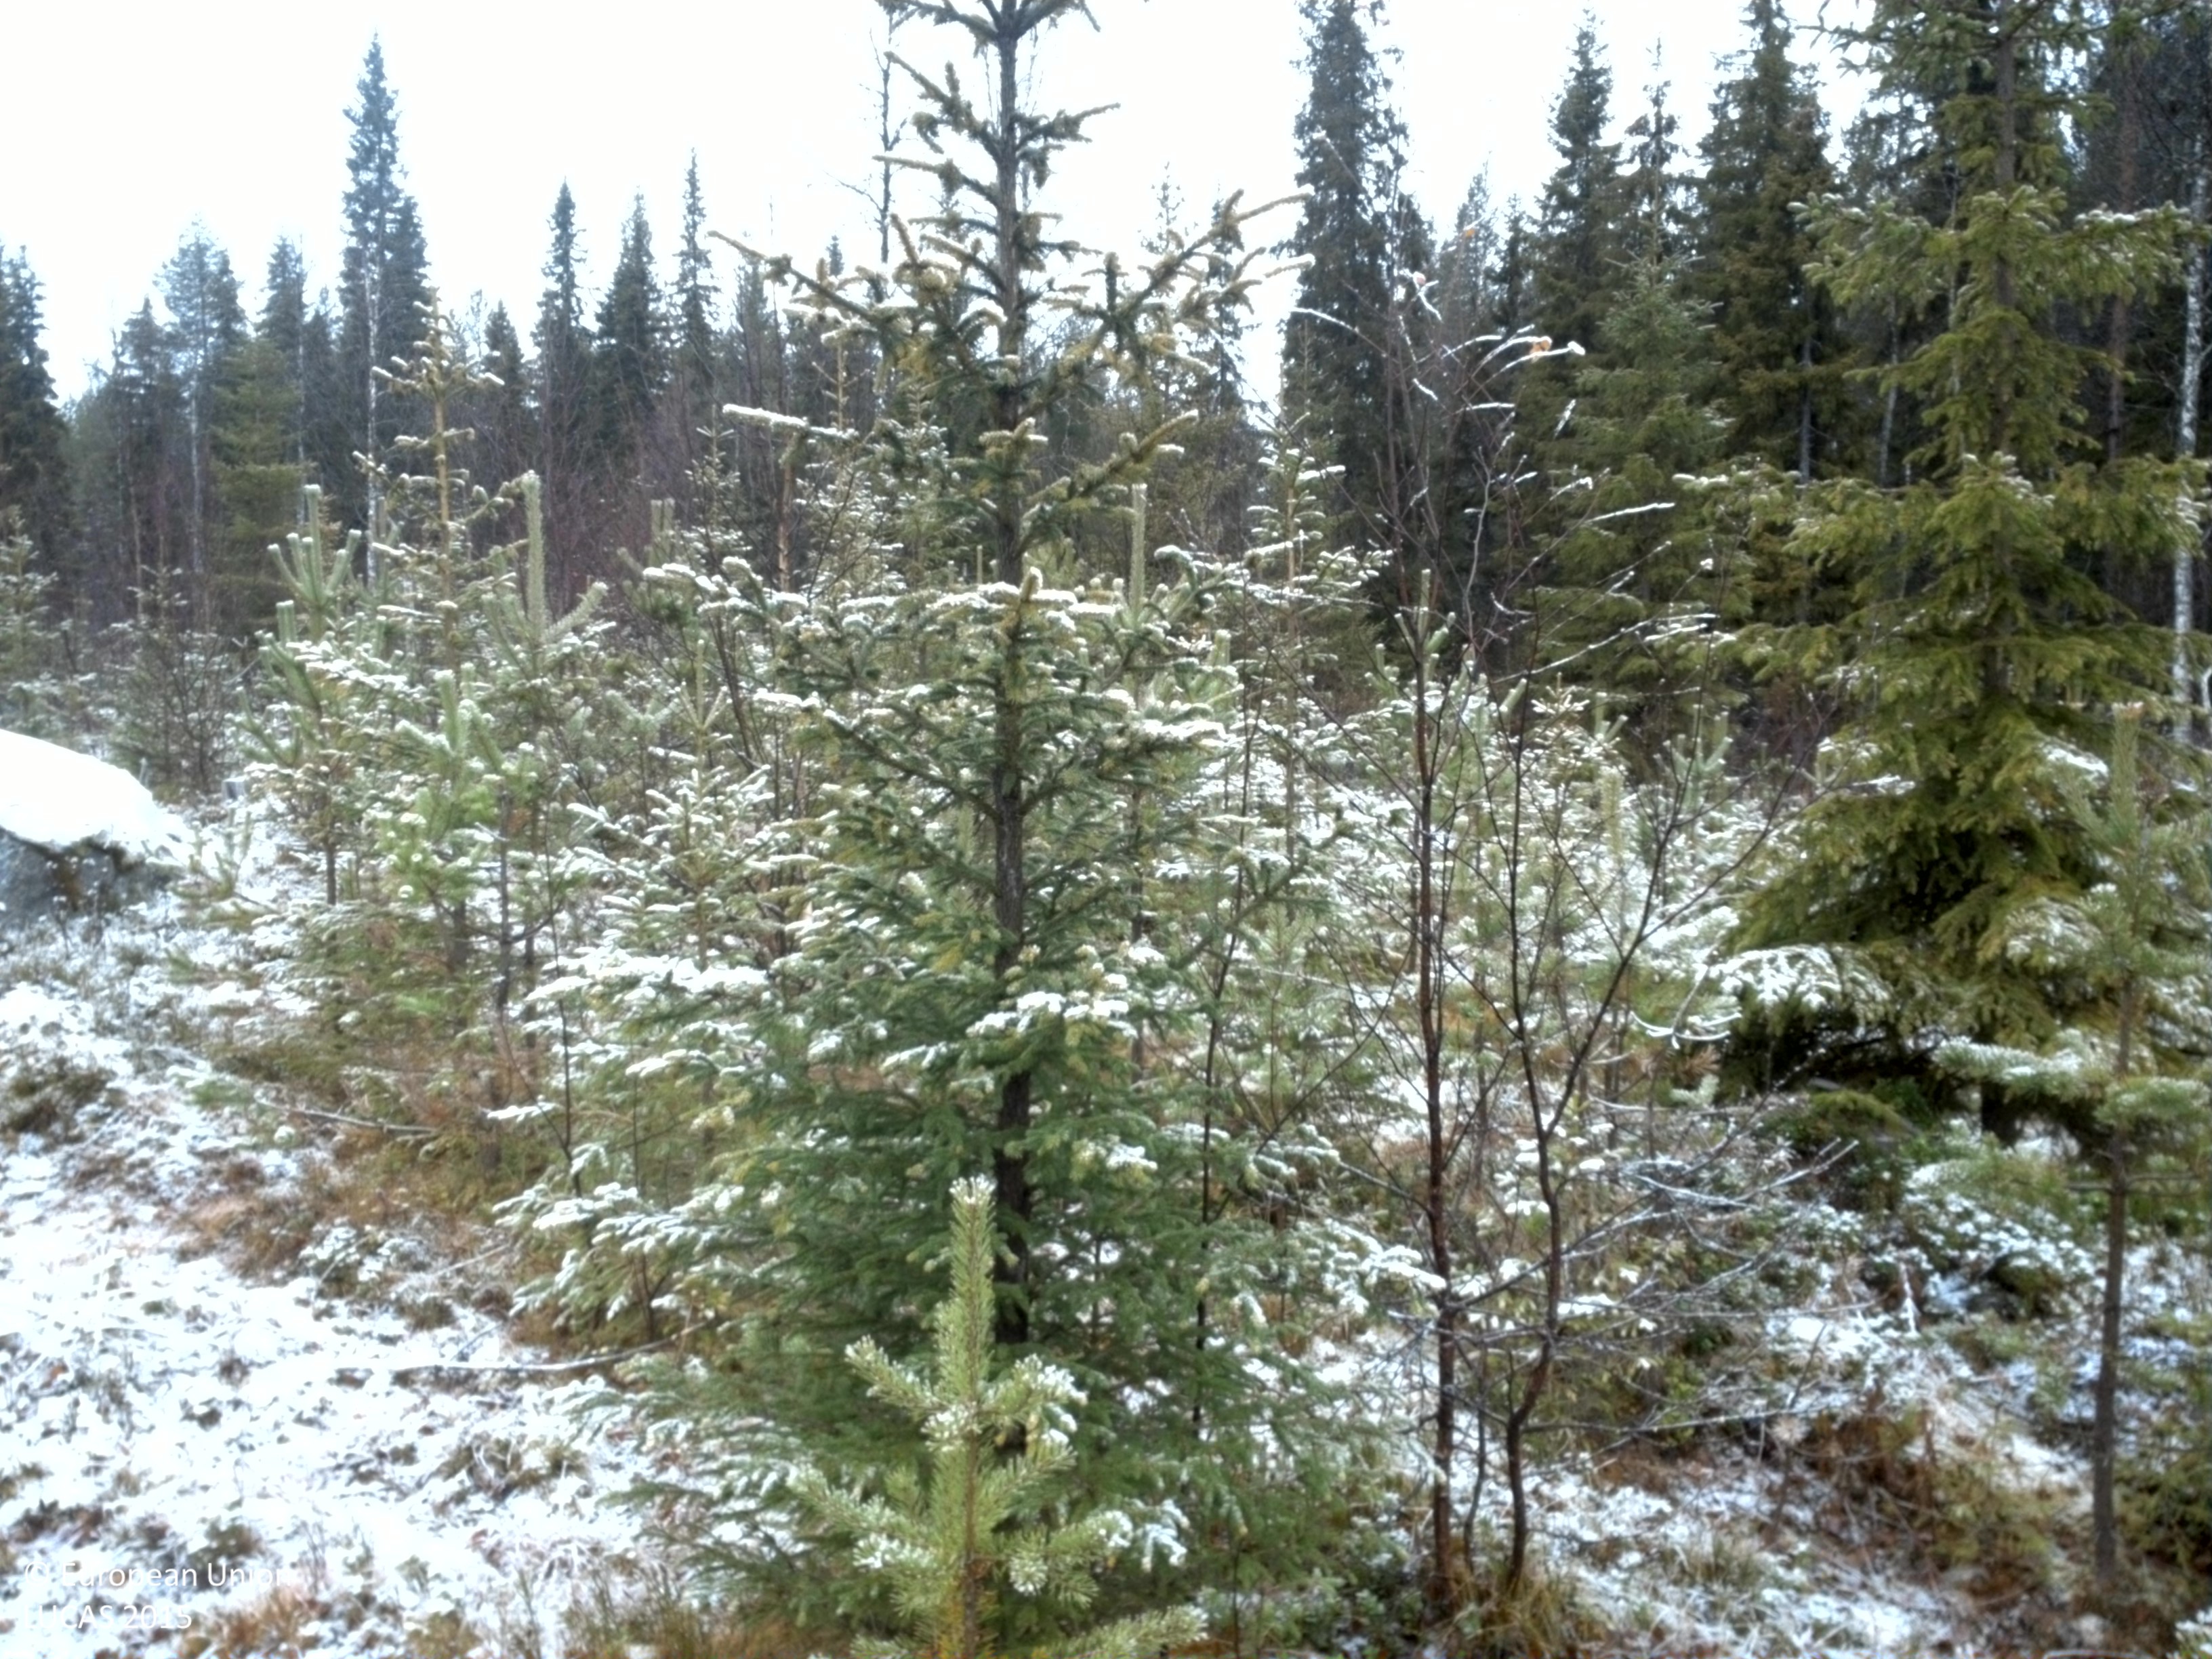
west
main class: Woodland
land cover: Other mixed woodland
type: boreal forest
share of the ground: 10 - 25 %
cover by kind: shrubs 35 %, herbaceous plants 30 %, coniferous forest trees 15 %, lichens and mosses 15 %, broadleaved forest trees 5 %
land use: Forestry
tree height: < 5 m
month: October
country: SE
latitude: 64.3833
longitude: 16.7056
